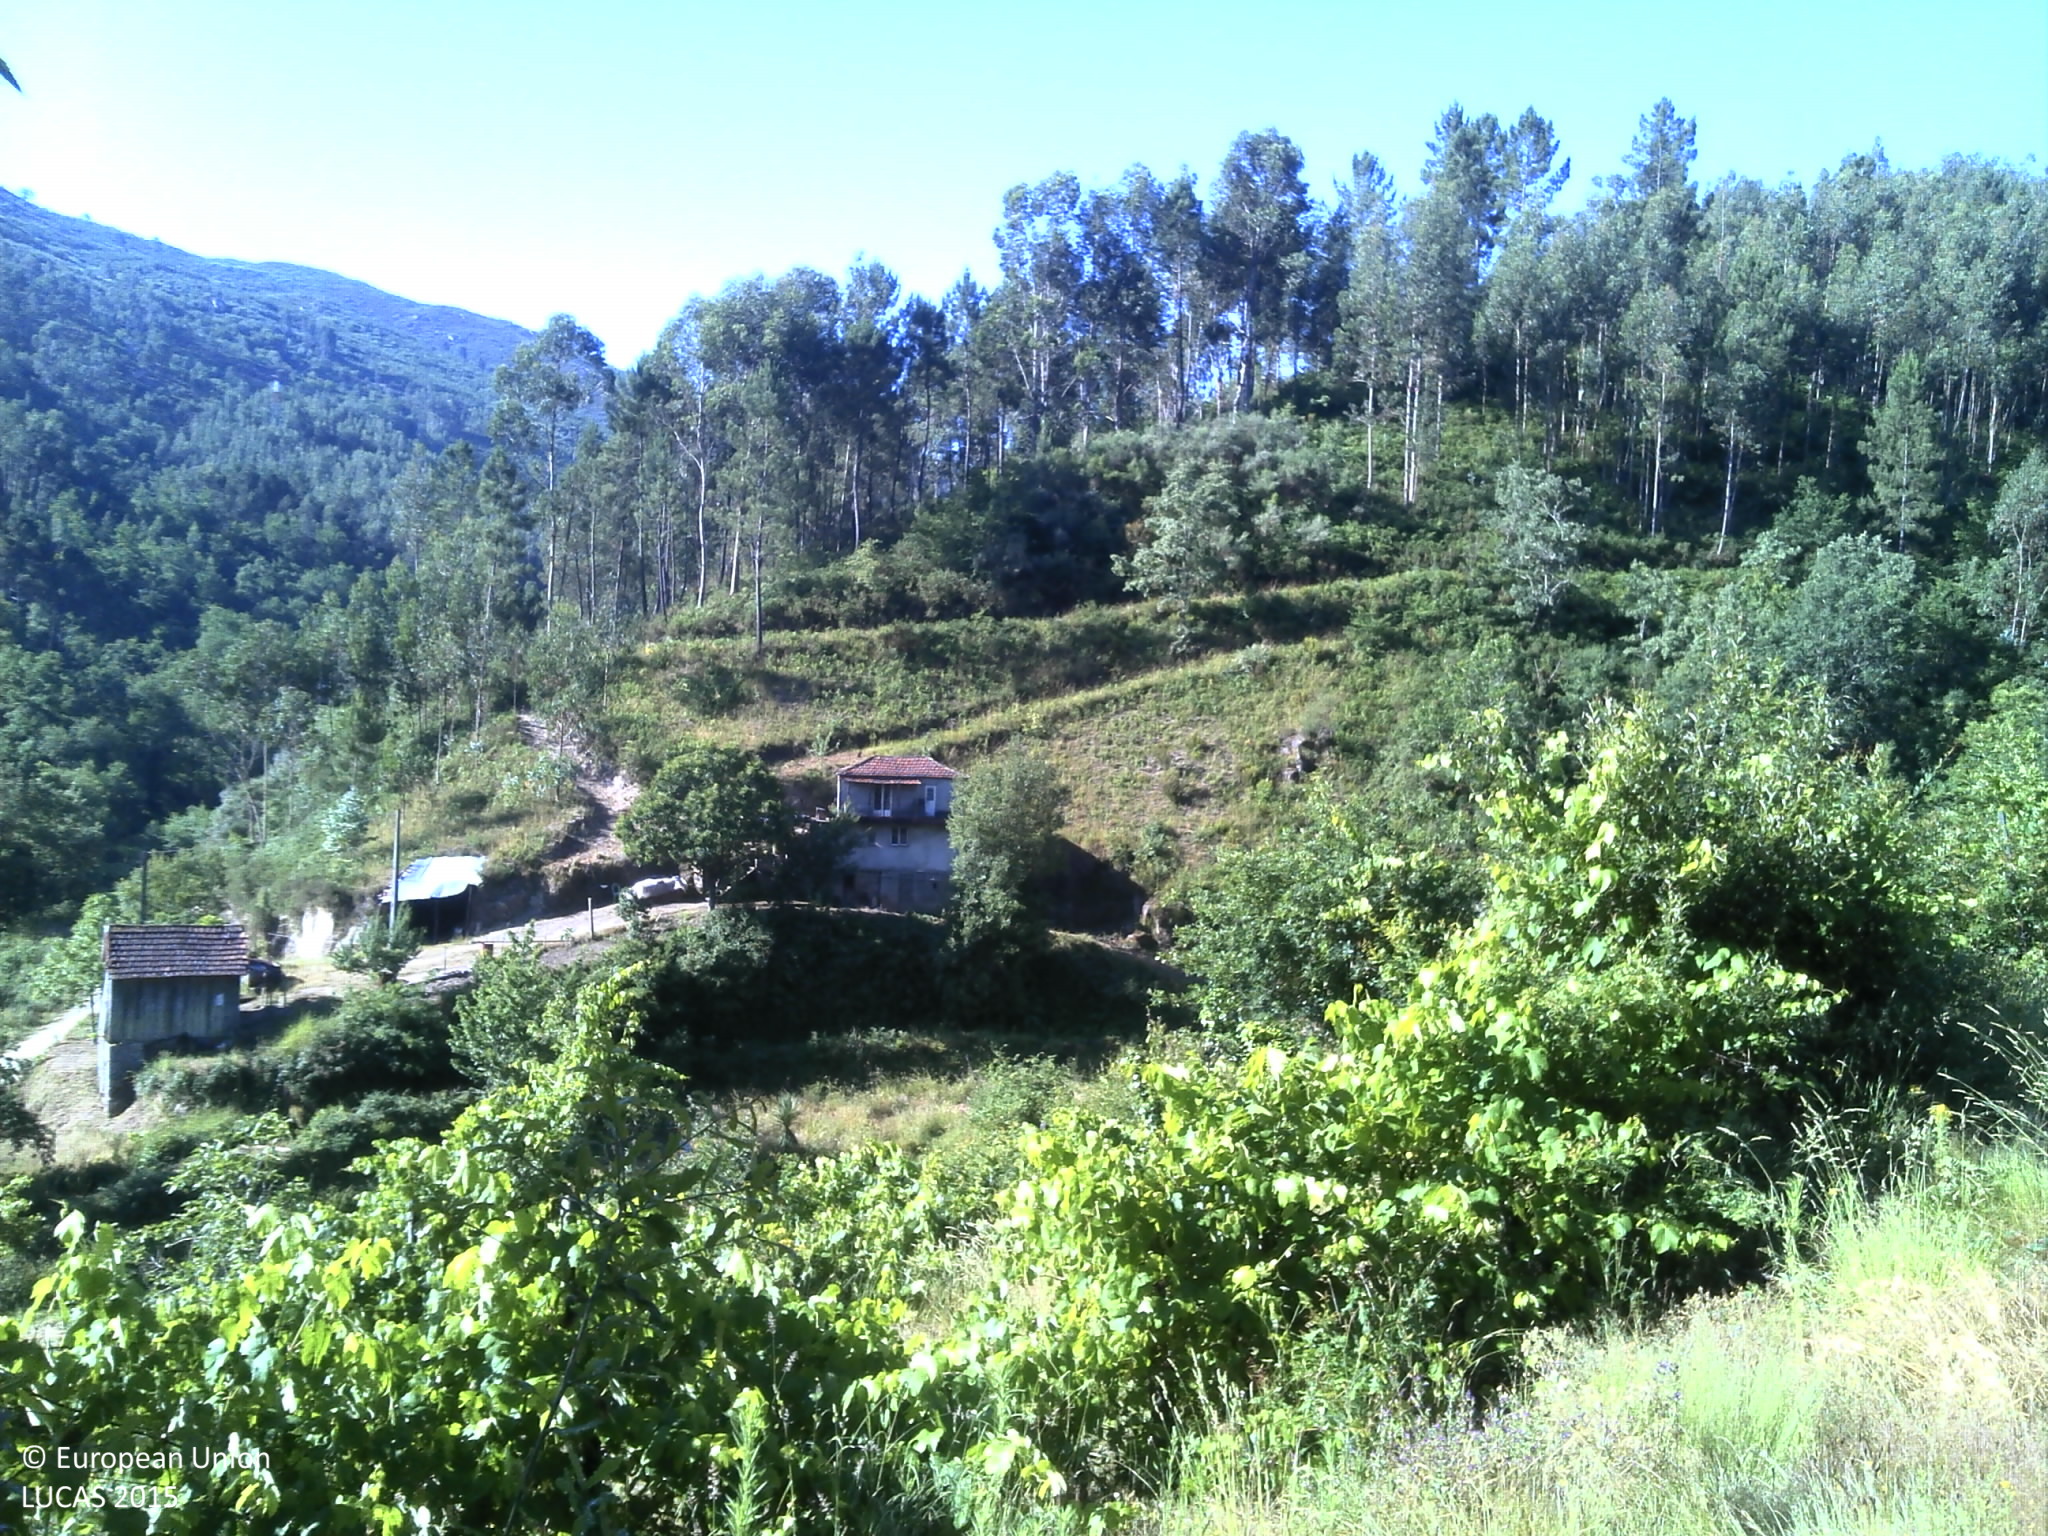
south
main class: Woodland
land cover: Broadleaved woodland
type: thermophilous deciduous forest
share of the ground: 25 - 50 %
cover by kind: broadleaved forest trees 50 %, shrubs 30 %, herbaceous plants 15 %, unconsolidated bare surface 5 %
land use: Forestry
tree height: > 5 m
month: June
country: PT
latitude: 40.8973
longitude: -7.9952
